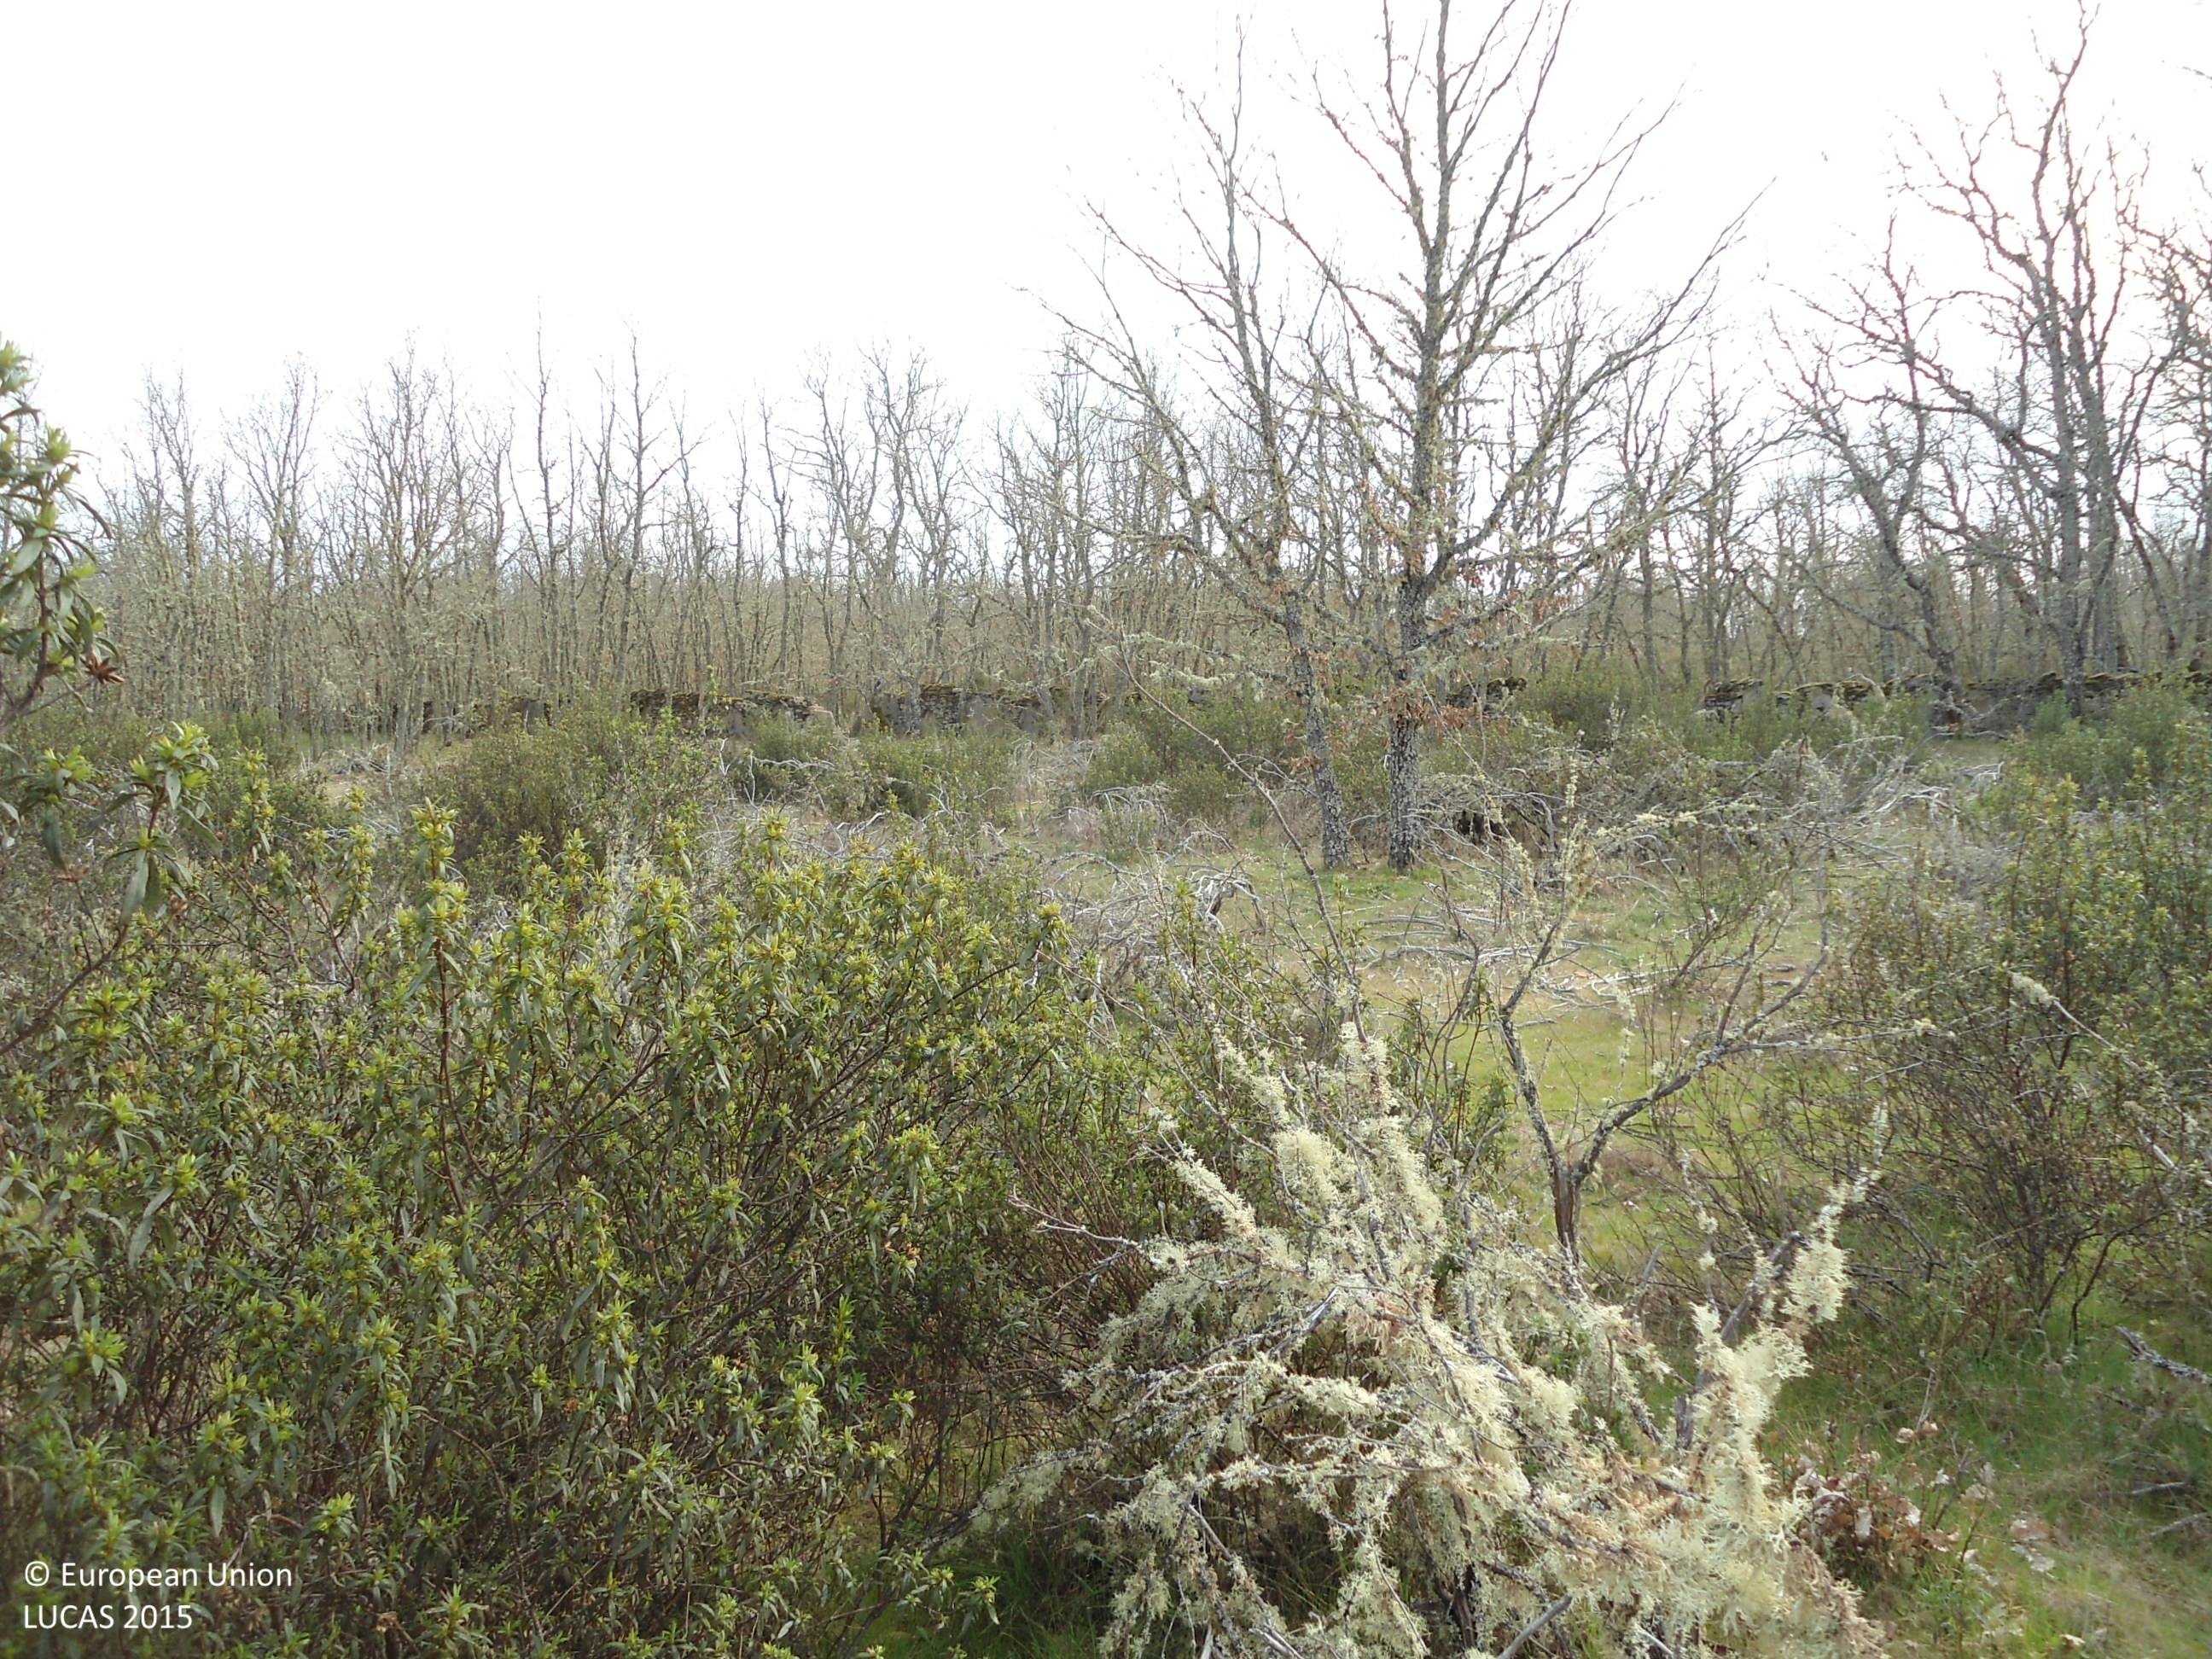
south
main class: Woodland
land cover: Broadleaved woodland
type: acidophilous oak and oak-birch forest
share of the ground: 25 - 50 %
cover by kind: broadleaved forest trees 50 %, shrubs 40 %, herbaceous plants 10 %
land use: Forestry
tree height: > 5 m
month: April
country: ES
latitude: 41.6660
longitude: -6.2287
